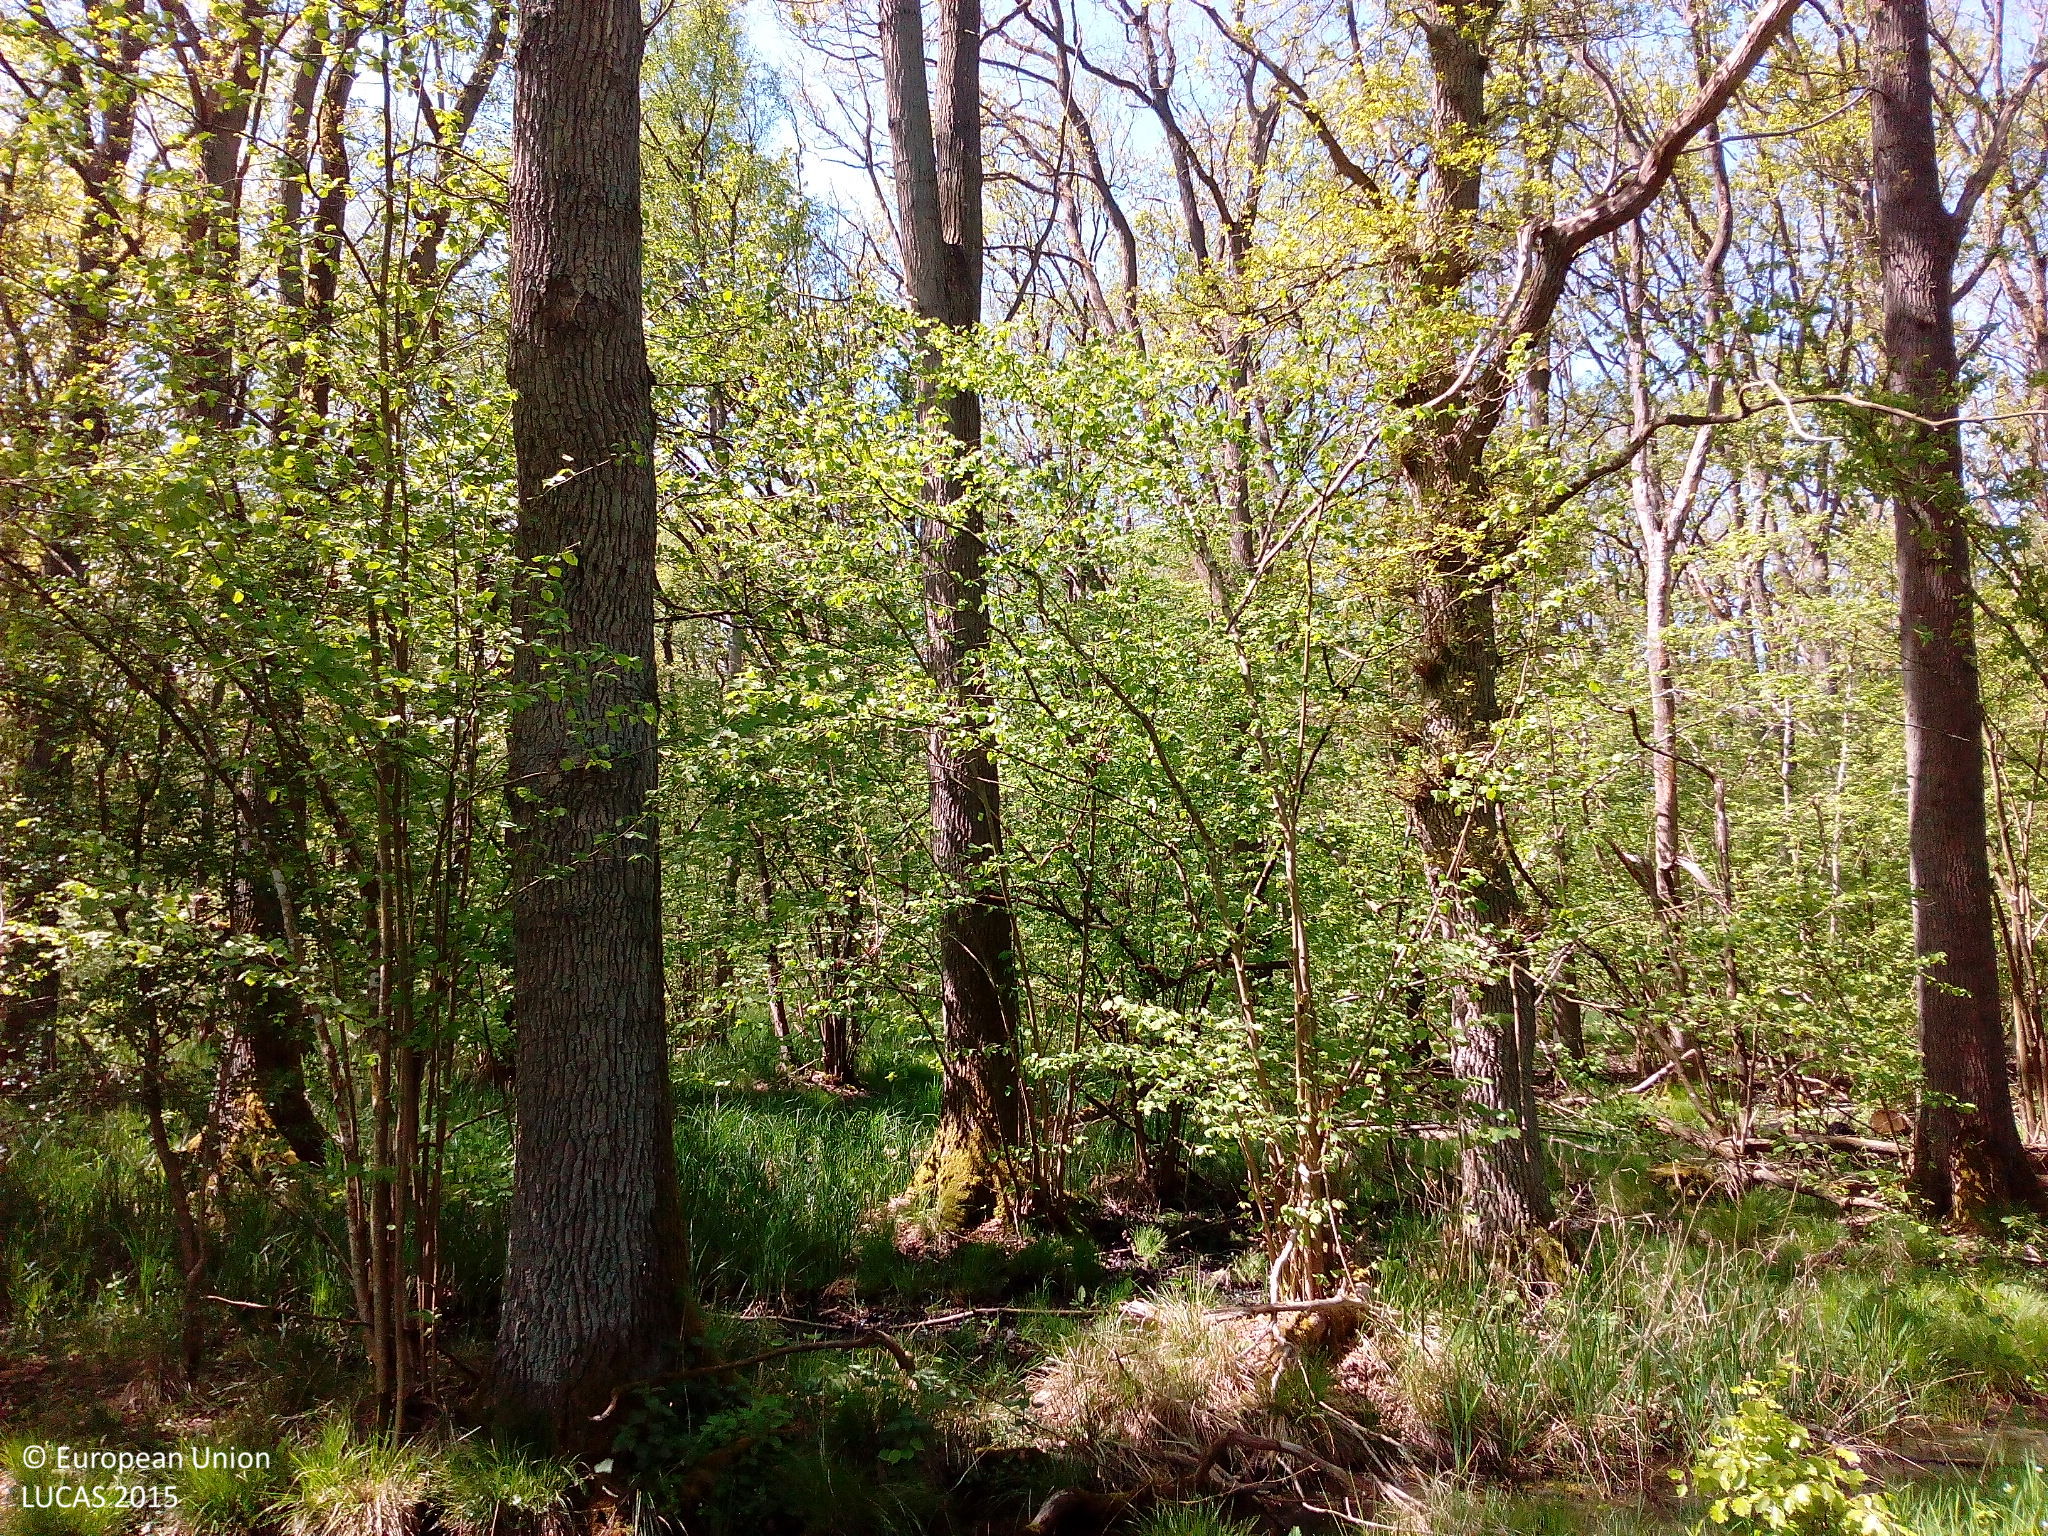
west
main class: Woodland
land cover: Broadleaved woodland
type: mesophytic deciduous forest
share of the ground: > 75 %
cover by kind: broadleaved forest trees 90 %, shrubs 5 %, herbaceous plants 5 %
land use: Forestry
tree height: > 5 m
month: May
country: DE
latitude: 54.3438
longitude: 12.6602
